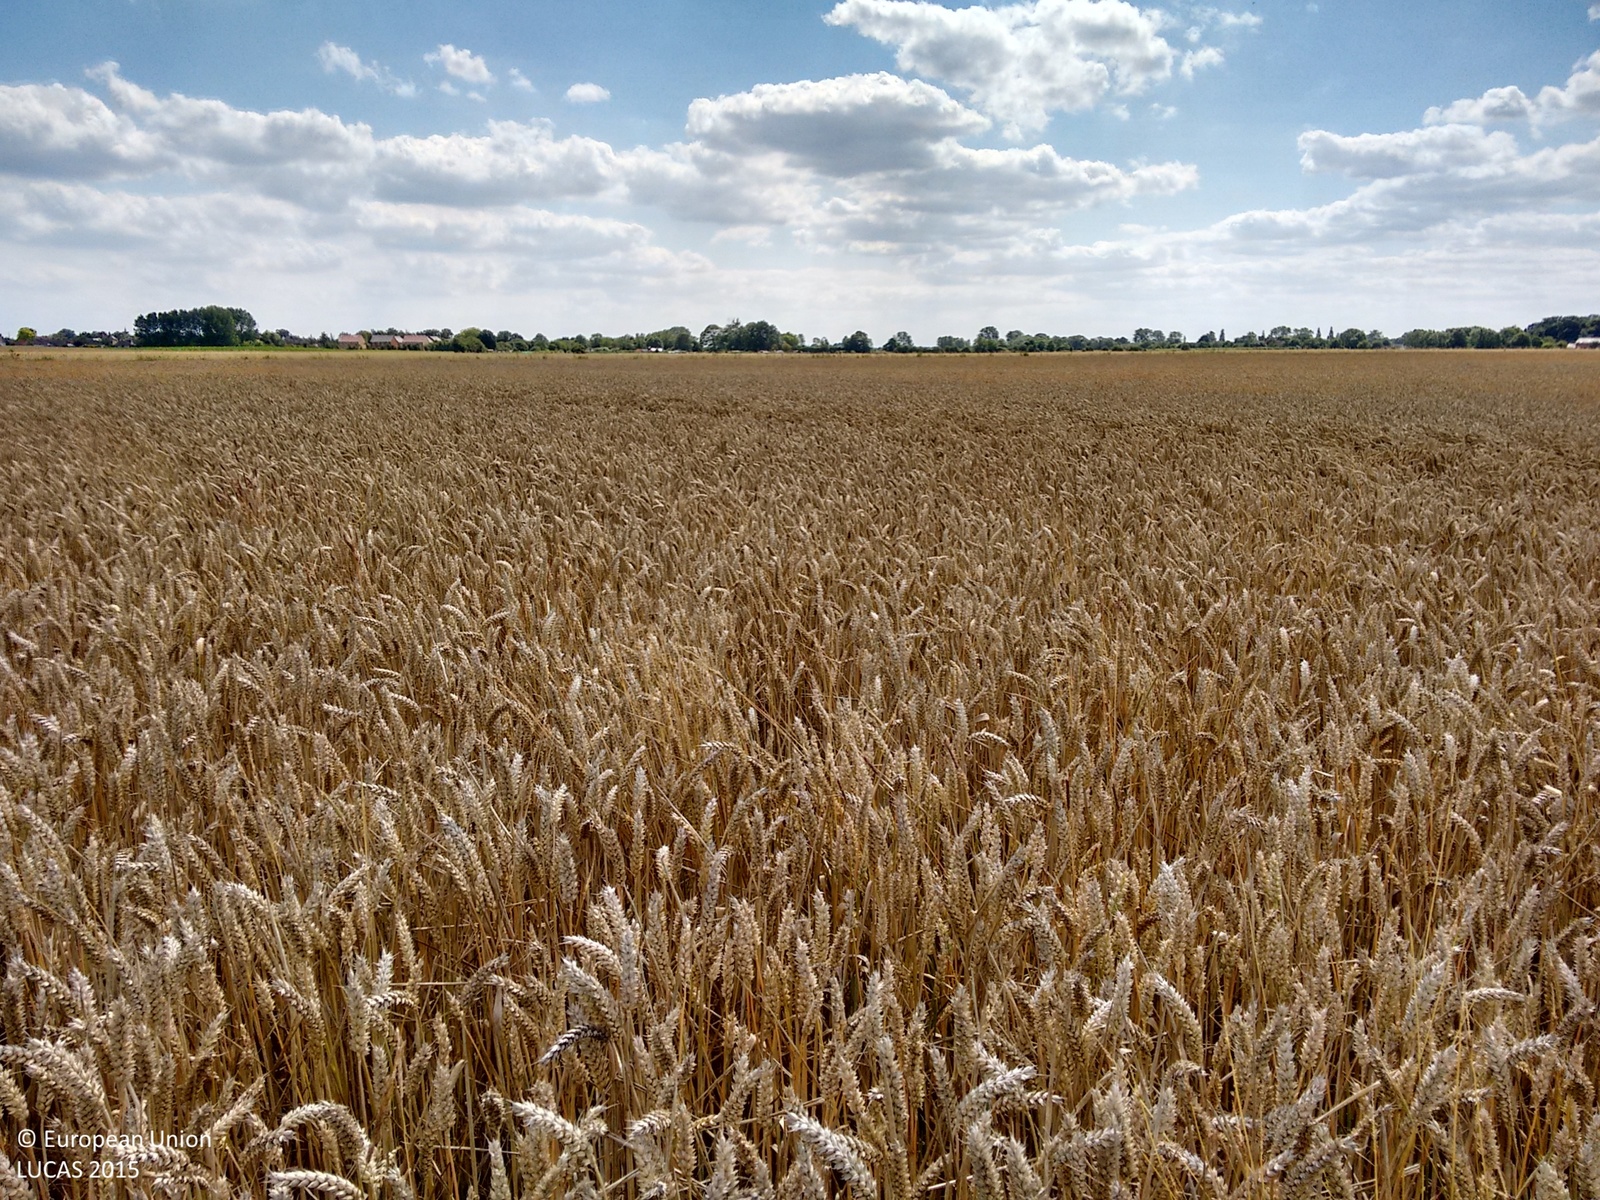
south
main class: Cropland
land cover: Common wheat
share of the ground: > 75 %
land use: Agriculture (excluding fallow land and kitchen gardens)
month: July
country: GB
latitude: 52.7649
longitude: 0.3829
